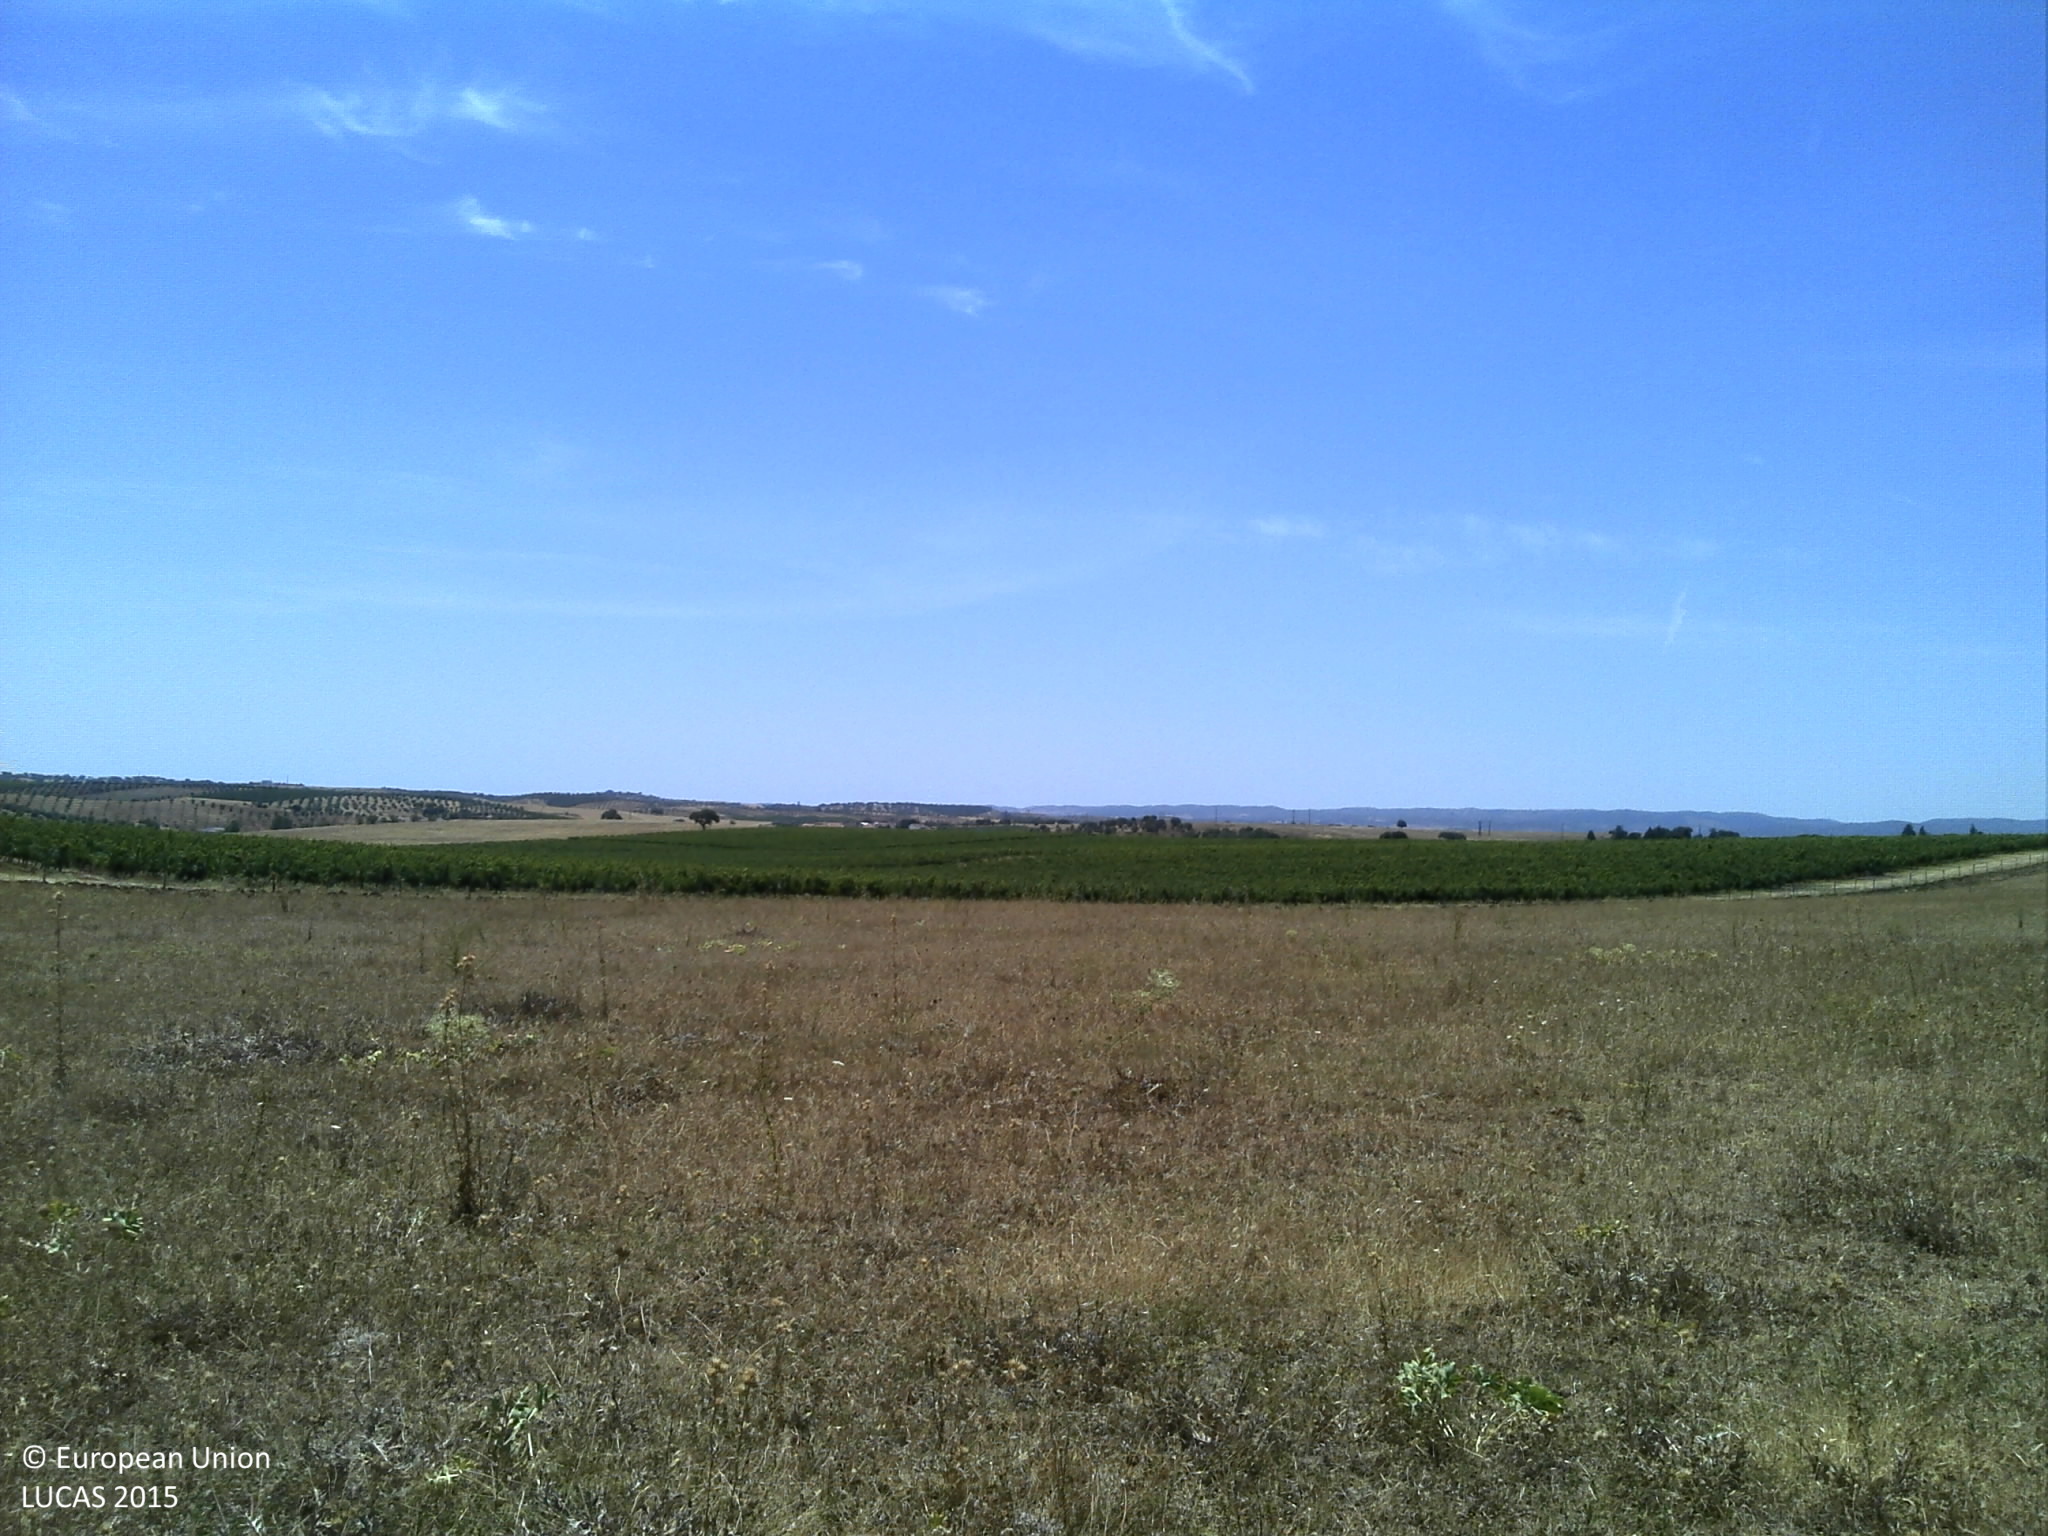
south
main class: Grassland
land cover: Spontaneously vegetated surfaces
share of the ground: 10 - 25 %
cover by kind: unconsolidated bare surface 85 %, herbaceous plants 15 %
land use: Agriculture (excluding fallow land and kitchen gardens)
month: July
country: PT
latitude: 38.4685
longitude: -7.6475
